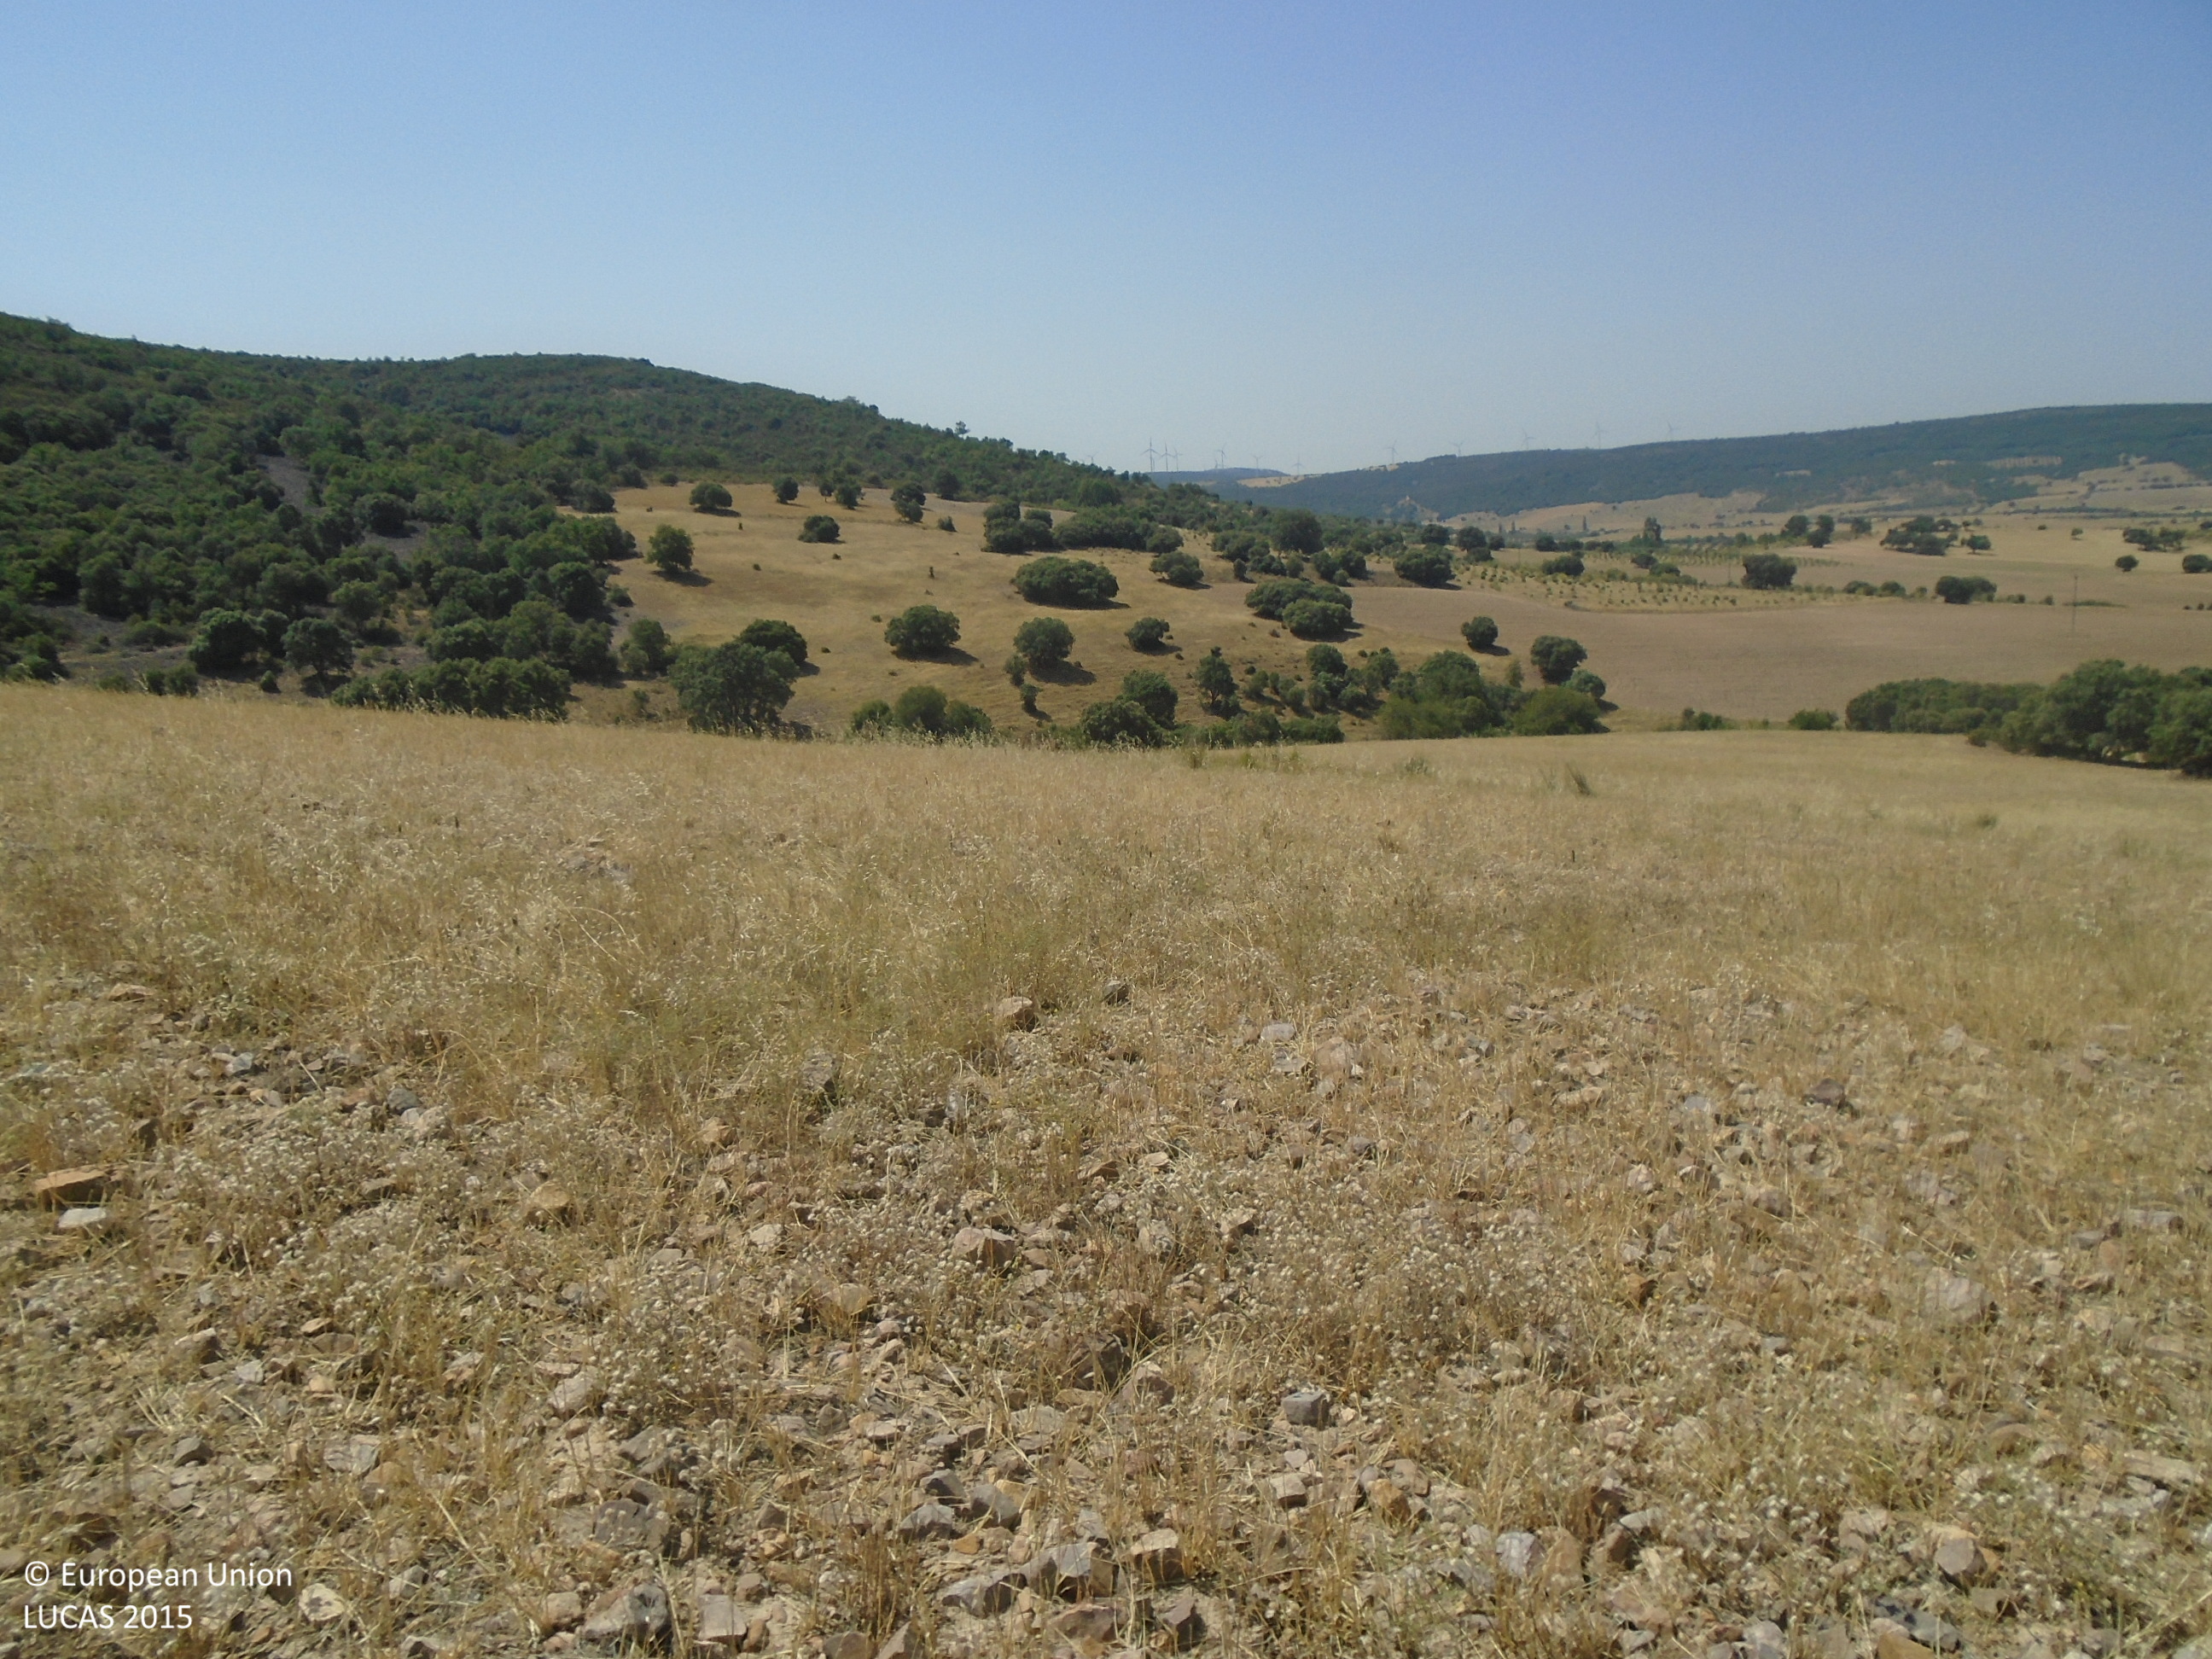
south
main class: Grassland
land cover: Spontaneously vegetated surfaces
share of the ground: > 75 %
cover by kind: herbaceous plants 80 %, consolidated bare surface 20 %
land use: Agriculture (excluding fallow land and kitchen gardens)
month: July
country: ES
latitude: 39.3383
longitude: -4.0778
